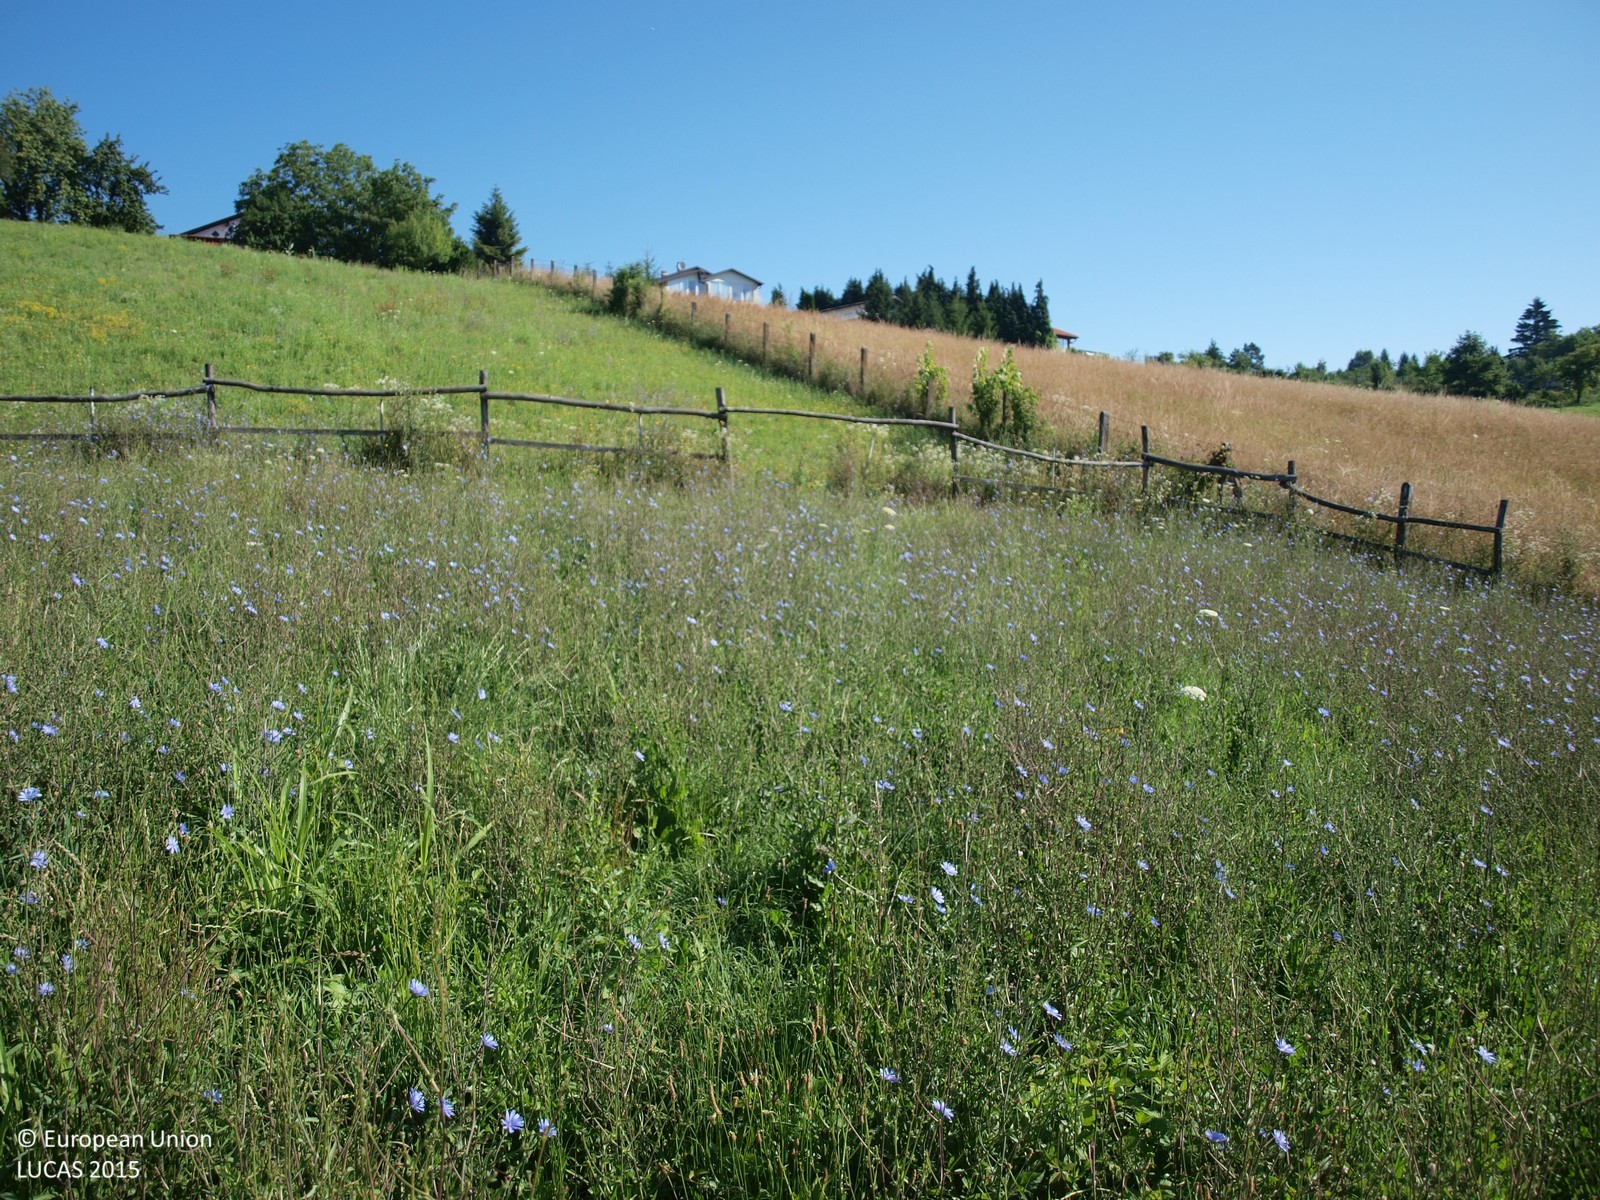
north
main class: Grassland
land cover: Grassland without tree/shrub cover
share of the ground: > 75 %
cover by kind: herbaceous plants 100 %
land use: Agriculture (excluding fallow land and kitchen gardens)
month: July
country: HR
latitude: 45.8919
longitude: 15.7067
